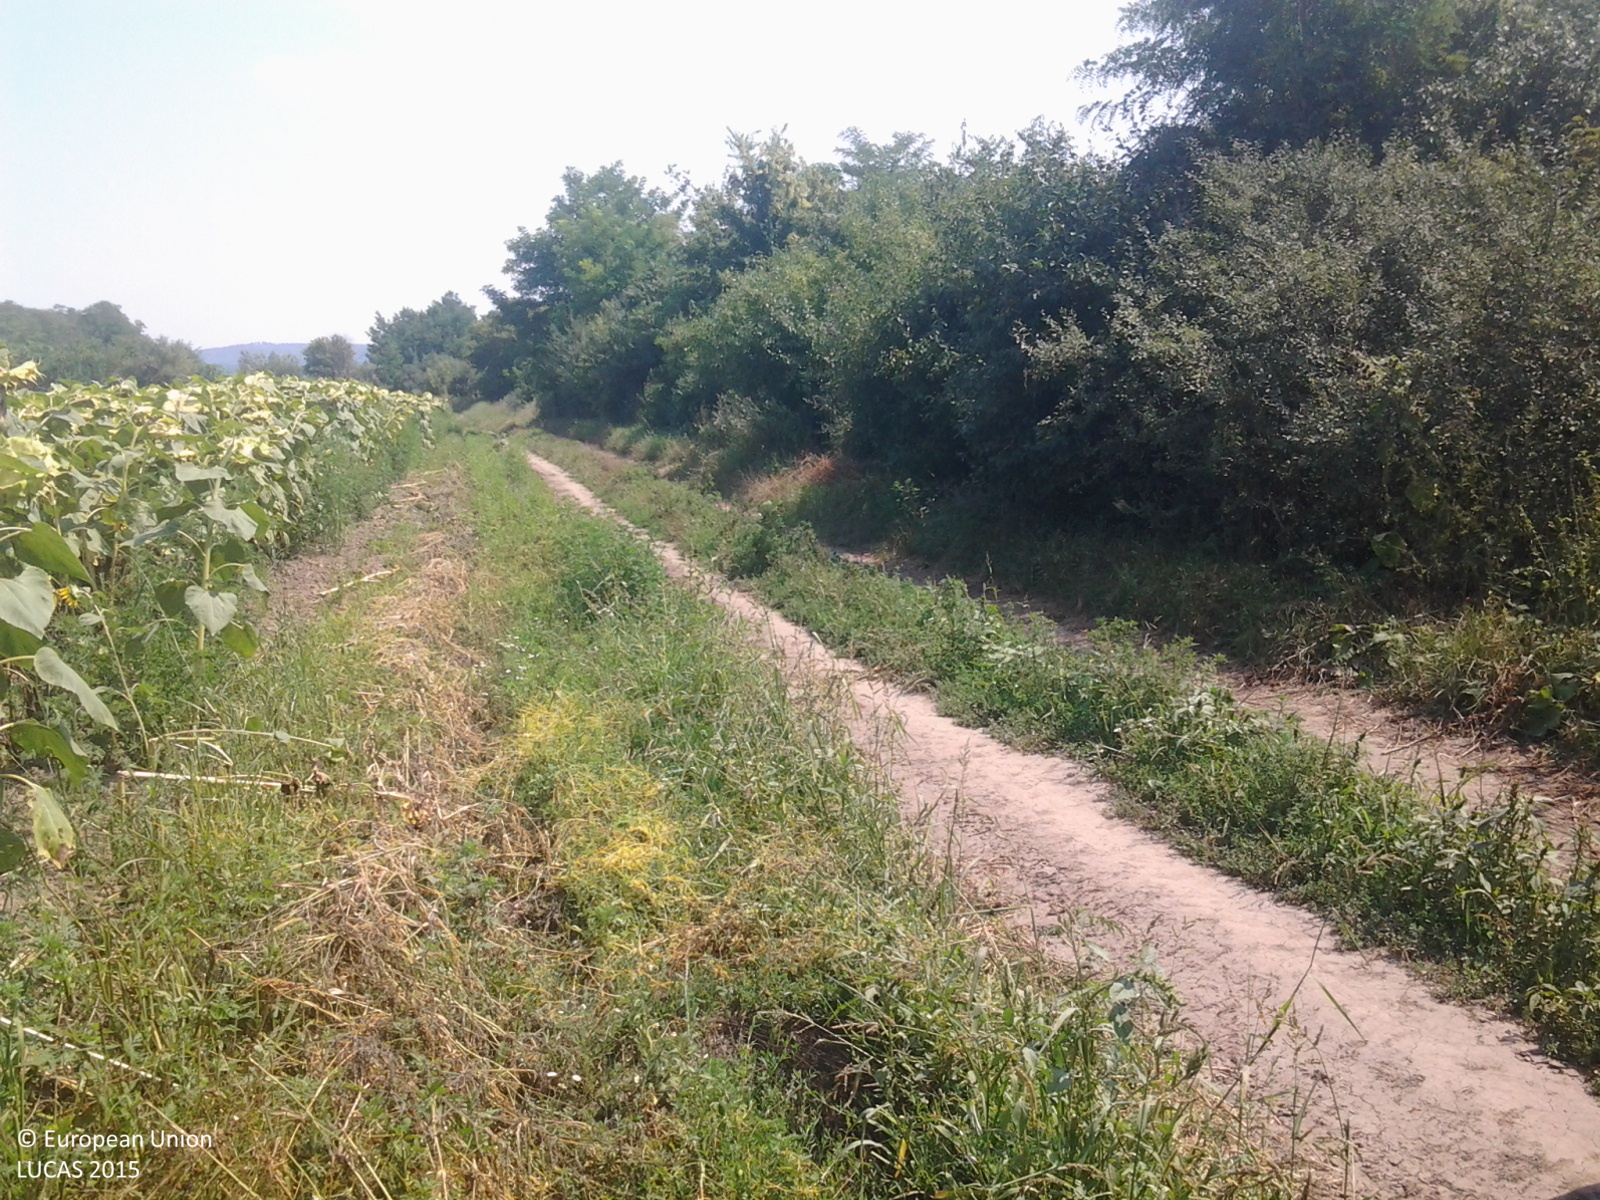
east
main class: Cropland
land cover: Sunflower
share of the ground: > 75 %
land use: Agriculture (excluding fallow land and kitchen gardens)
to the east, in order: Sunflower; Tracks; Fences; Shrubland with sparse tree cover; Ditches and canals; Shrubland with sparse tree cover; Spontaneously vegetated surfaces
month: August
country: HU
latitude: 46.6371
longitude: 18.3835
